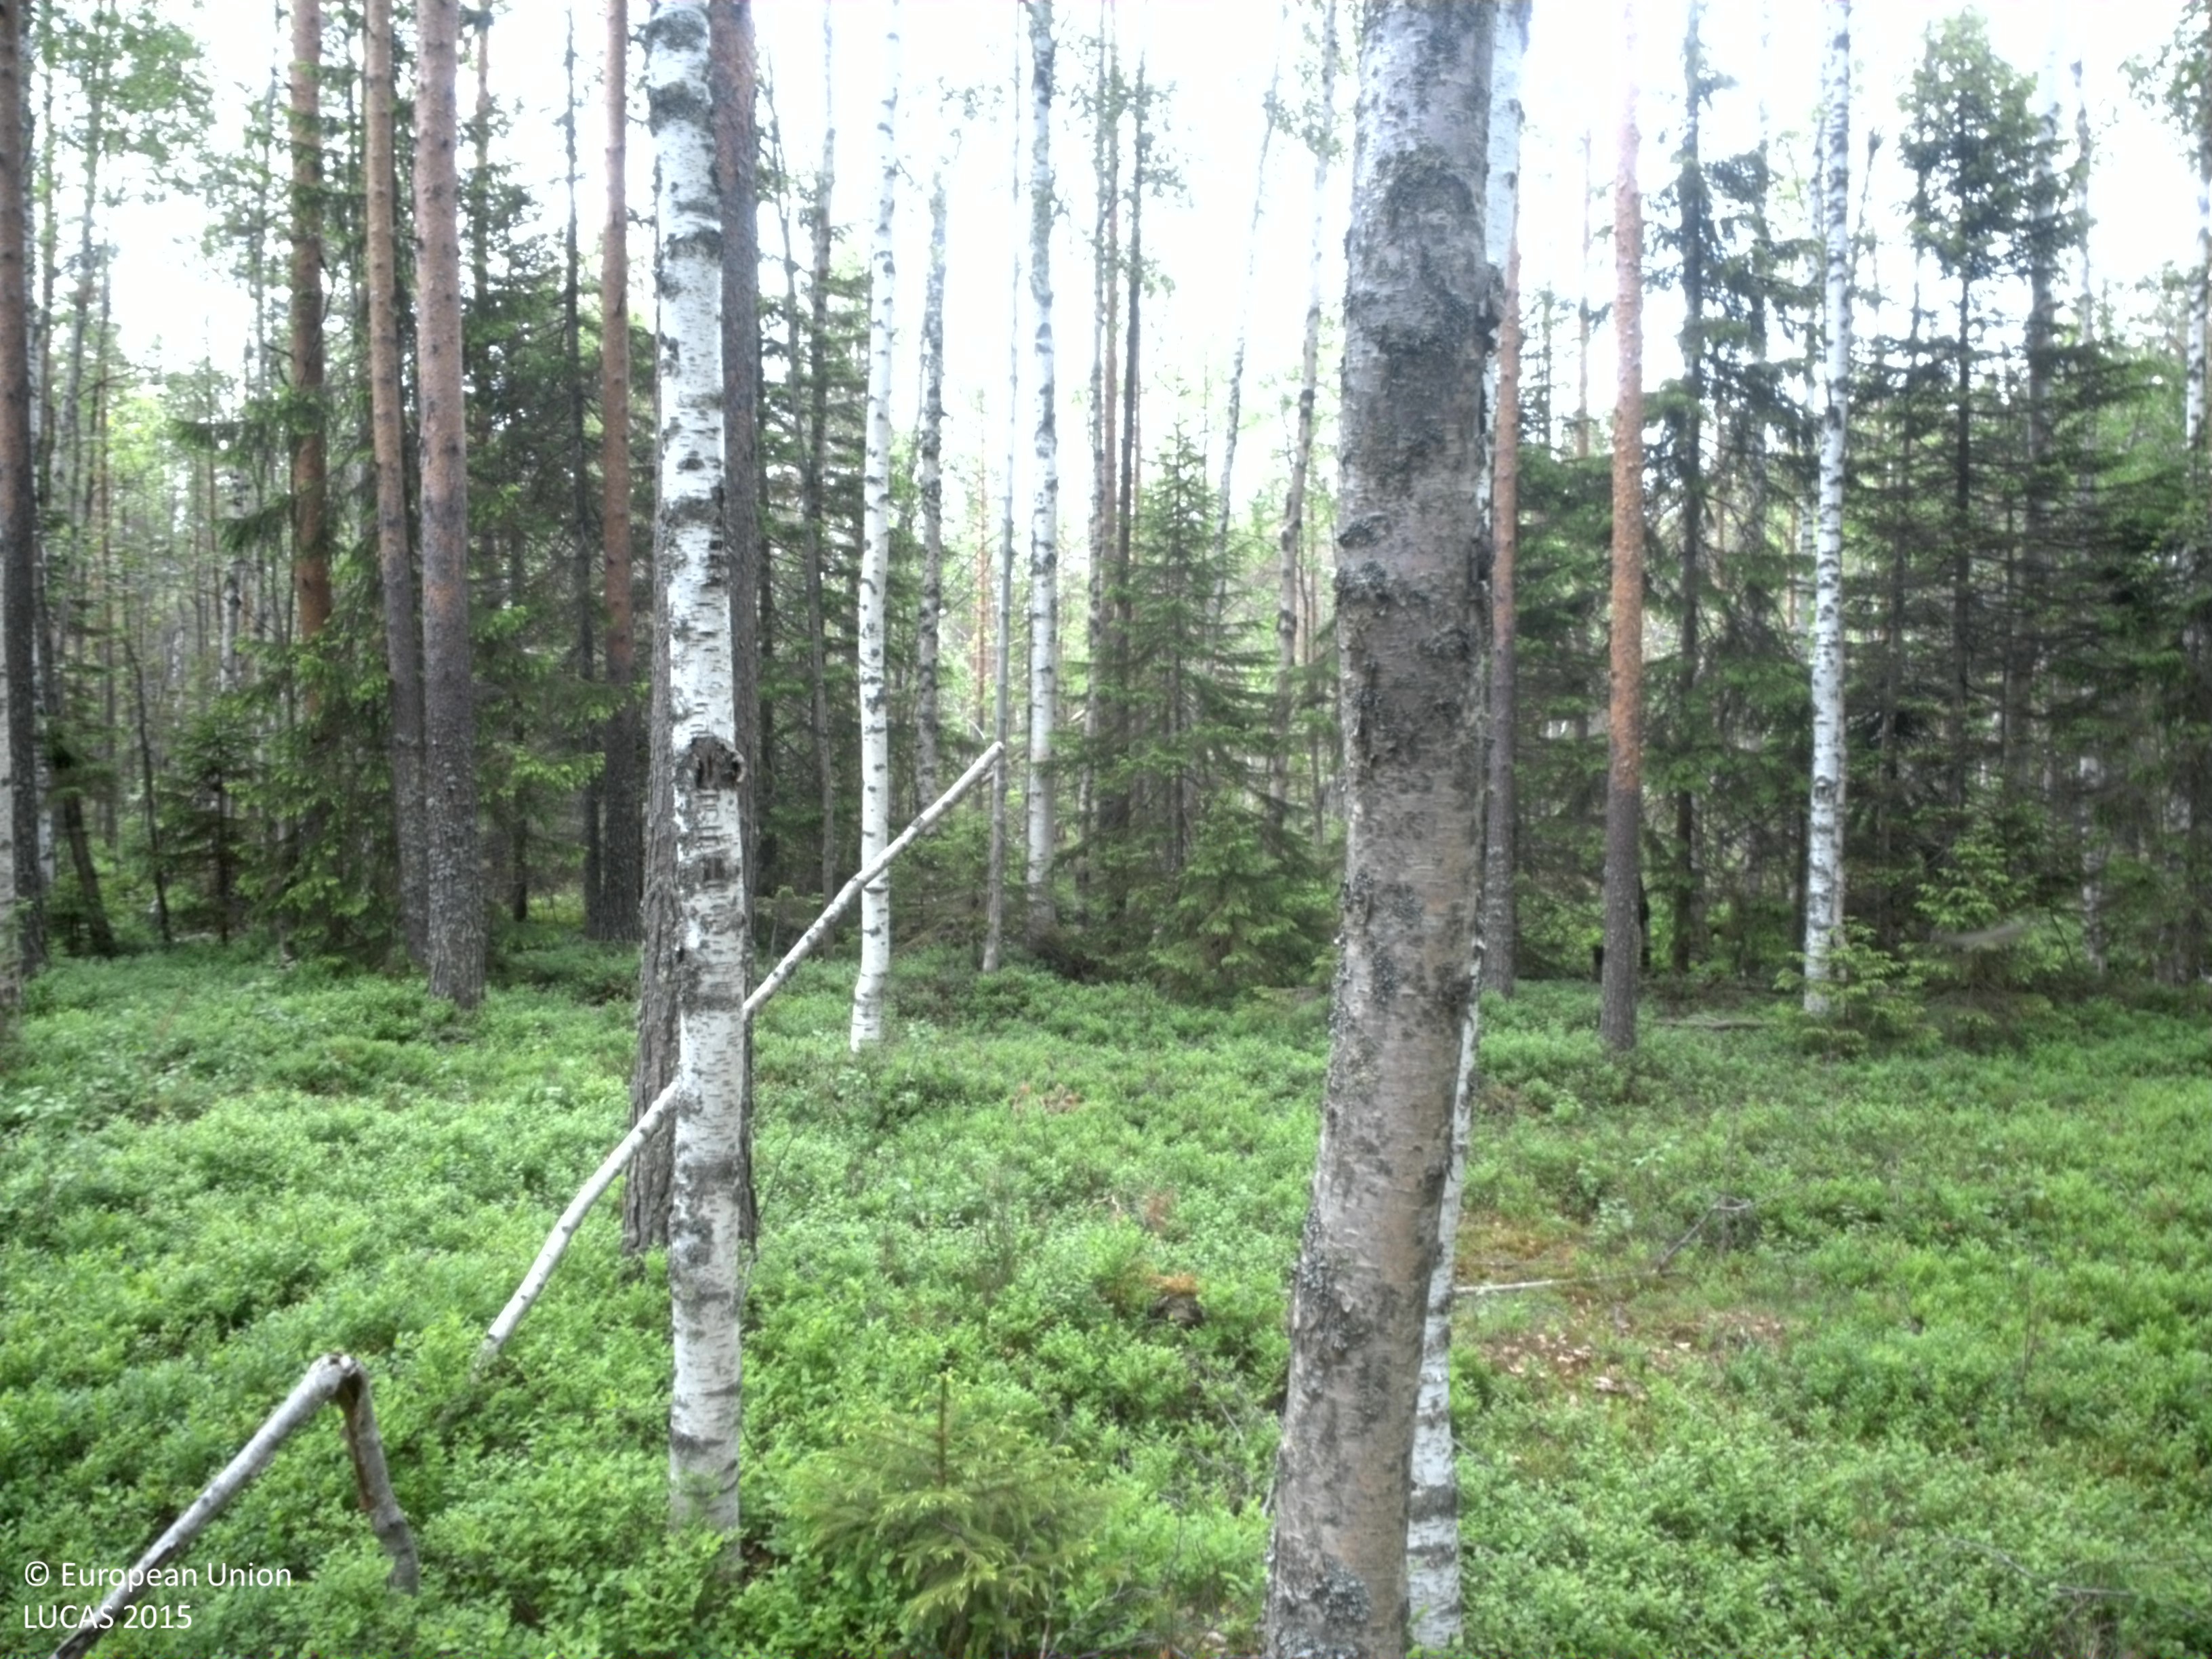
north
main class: Woodland
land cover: Other mixed woodland
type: boreal forest
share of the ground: 25 - 50 %
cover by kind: shrubs 40 %, coniferous forest trees 30 %, broadleaved forest trees 10 %, herbaceous plants 10 %, lichens and mosses 10 %
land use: Forestry
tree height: > 5 m
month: June
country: SE
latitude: 64.1815
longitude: 20.7035
